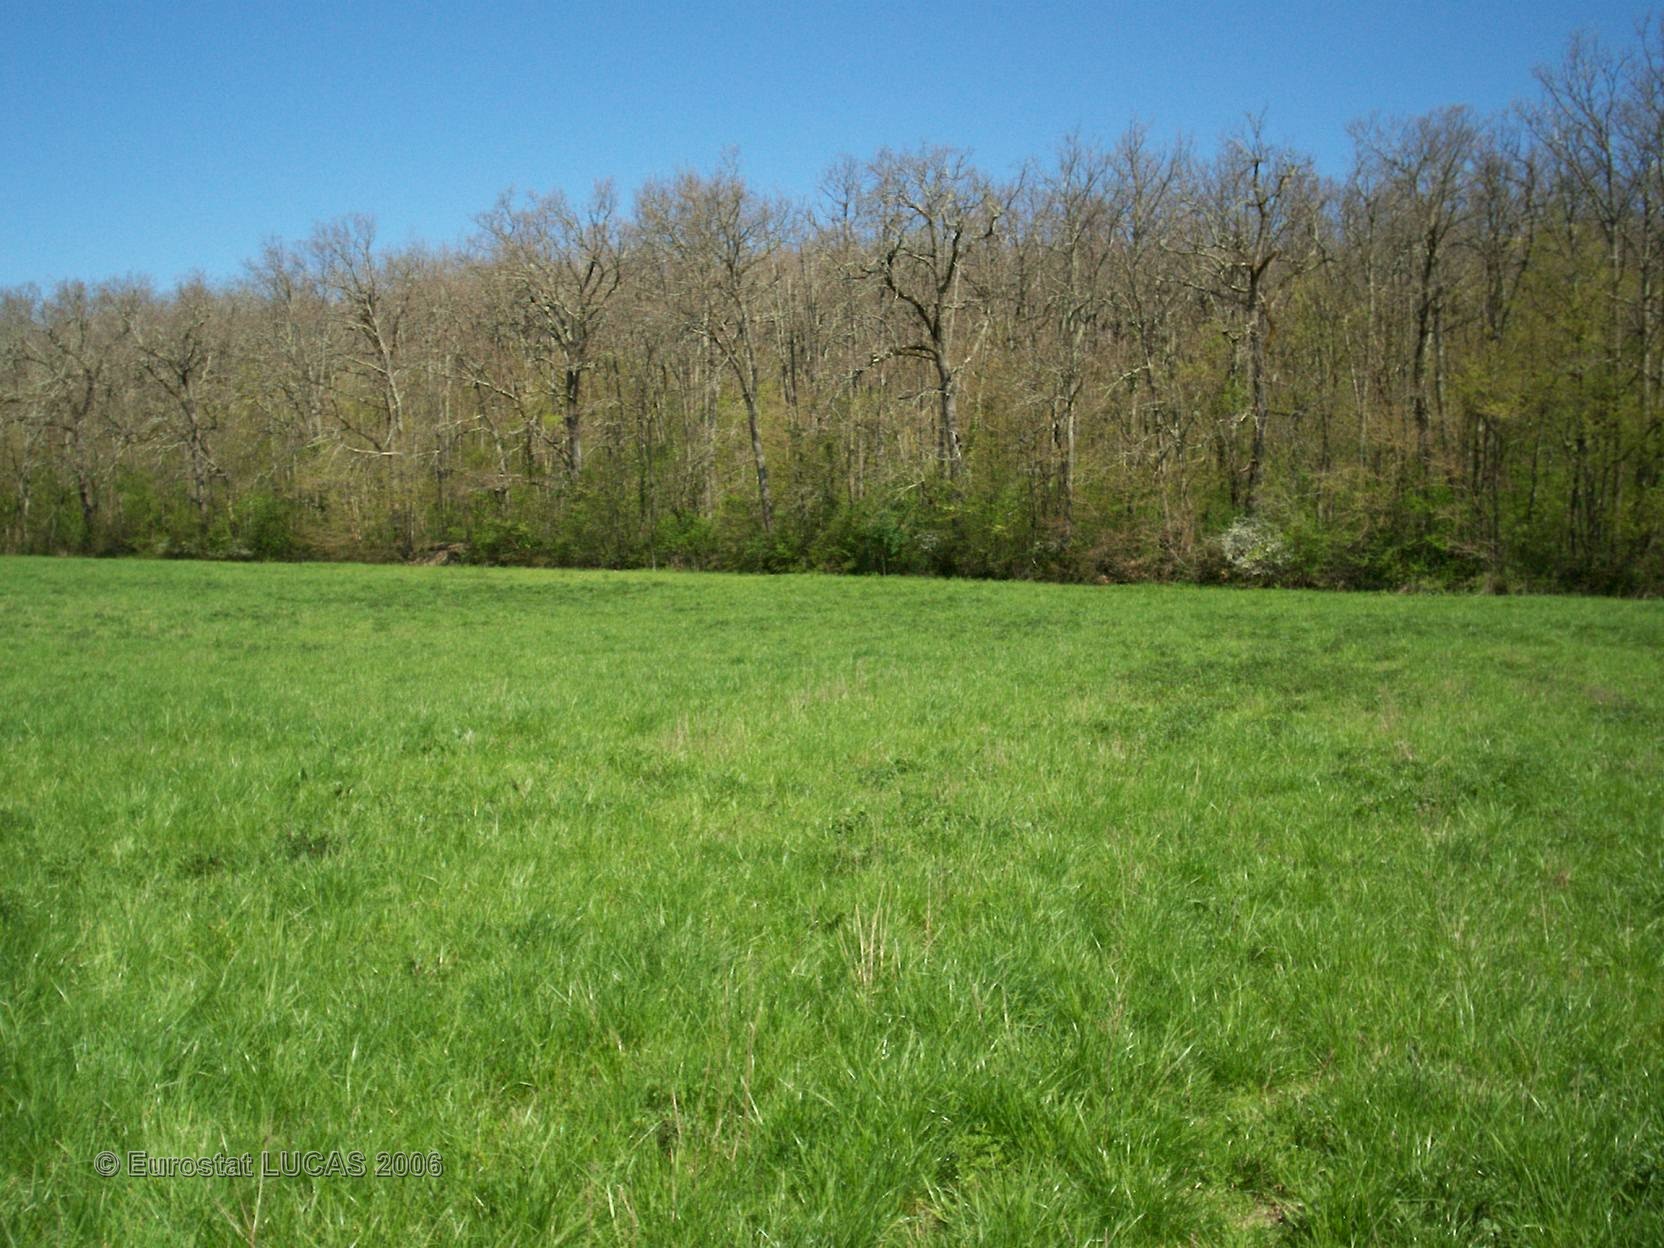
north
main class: Grassland
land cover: Grassland without tree/shrub cover
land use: Agriculture (excluding fallow land and kitchen gardens)
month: April
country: FR
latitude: 43.5198
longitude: 2.0506
